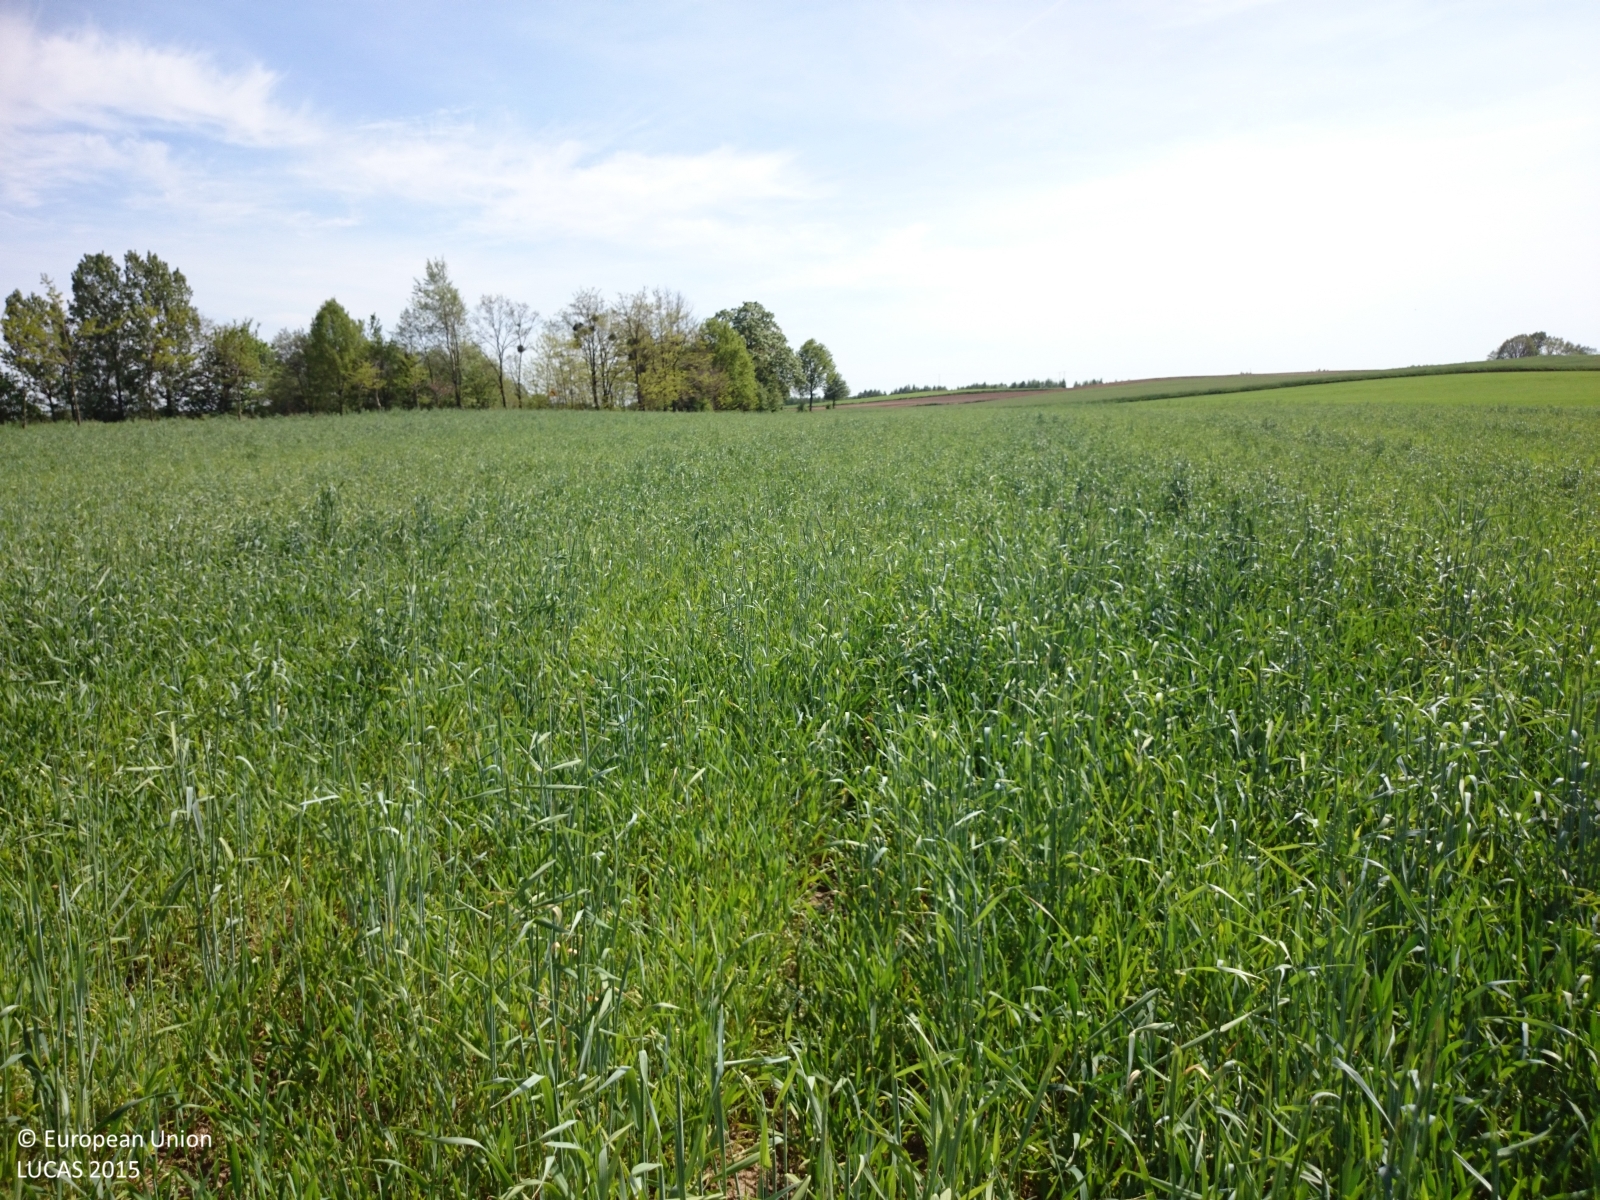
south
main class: Cropland
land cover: Rye
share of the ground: > 75 %
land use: Agriculture (excluding fallow land and kitchen gardens)
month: May
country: PL
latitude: 52.5556
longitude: 16.2454
